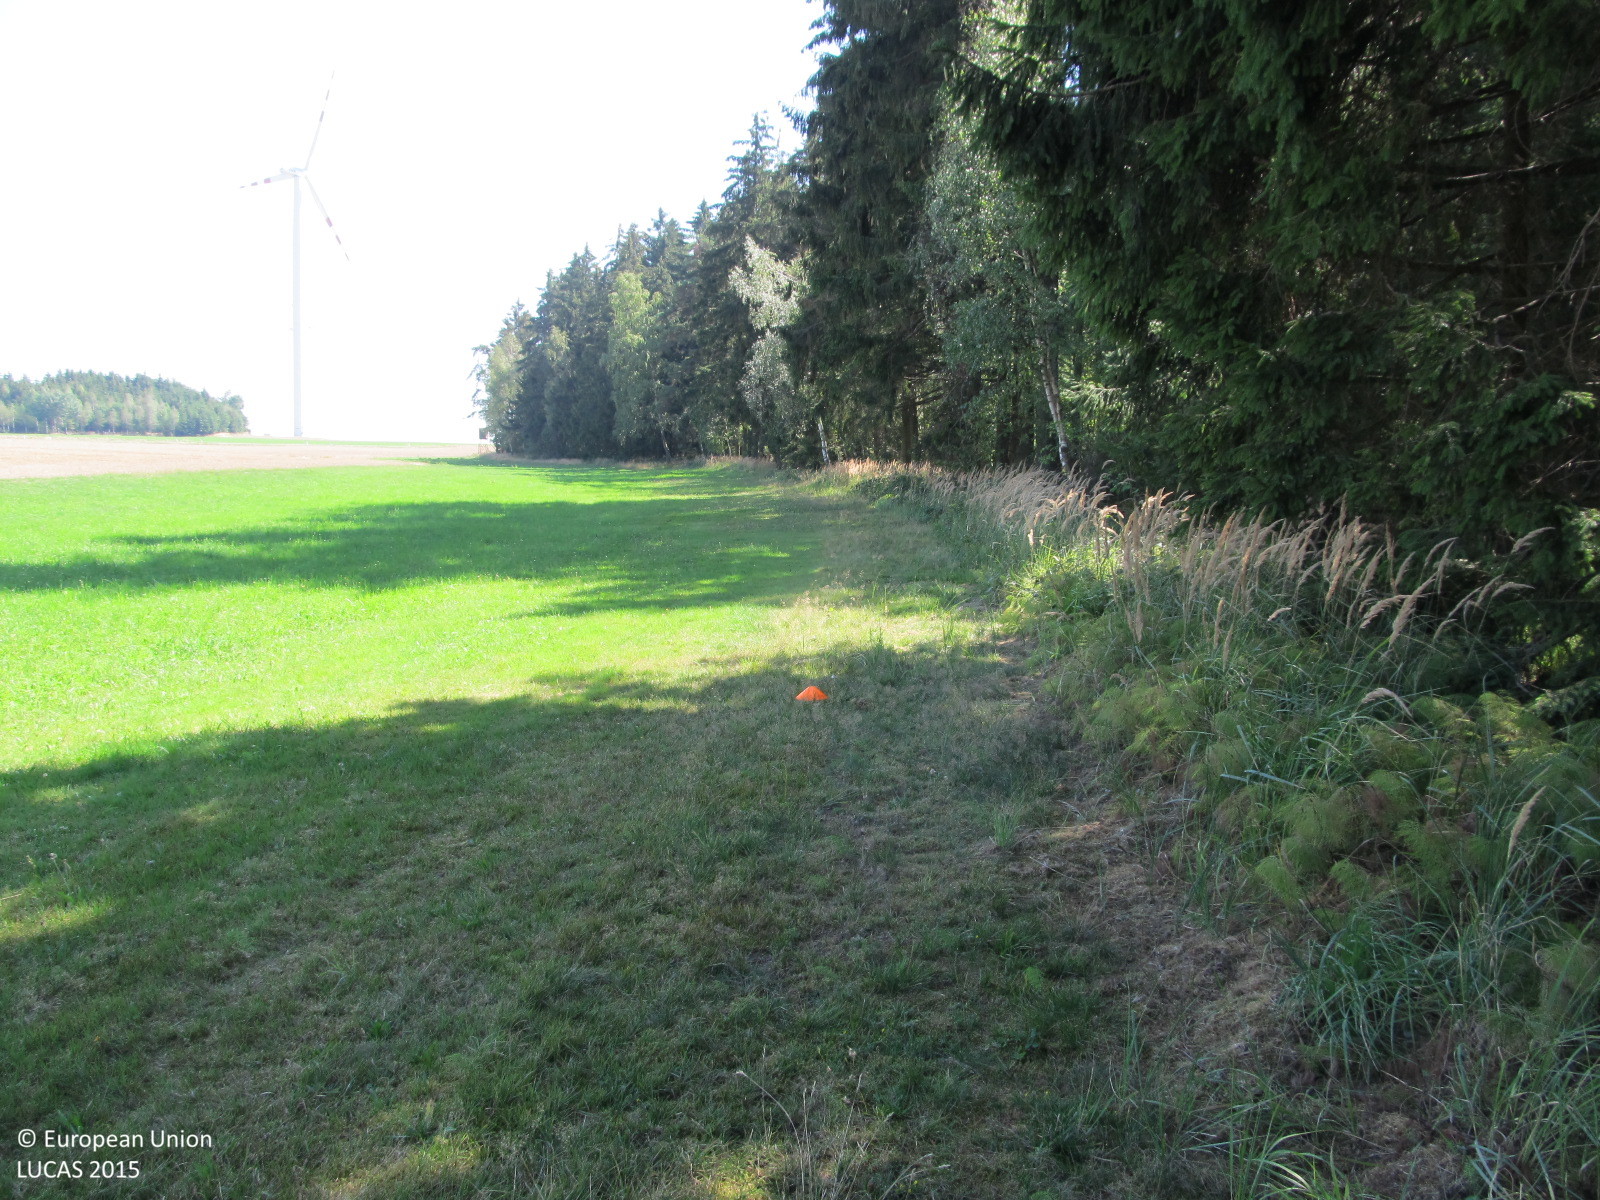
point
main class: Grassland
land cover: Grassland without tree/shrub cover
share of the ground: > 75 %
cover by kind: herbaceous plants 100 %
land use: Agriculture (excluding fallow land and kitchen gardens)
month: August
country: AT
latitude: 48.7888
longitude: 15.5157
